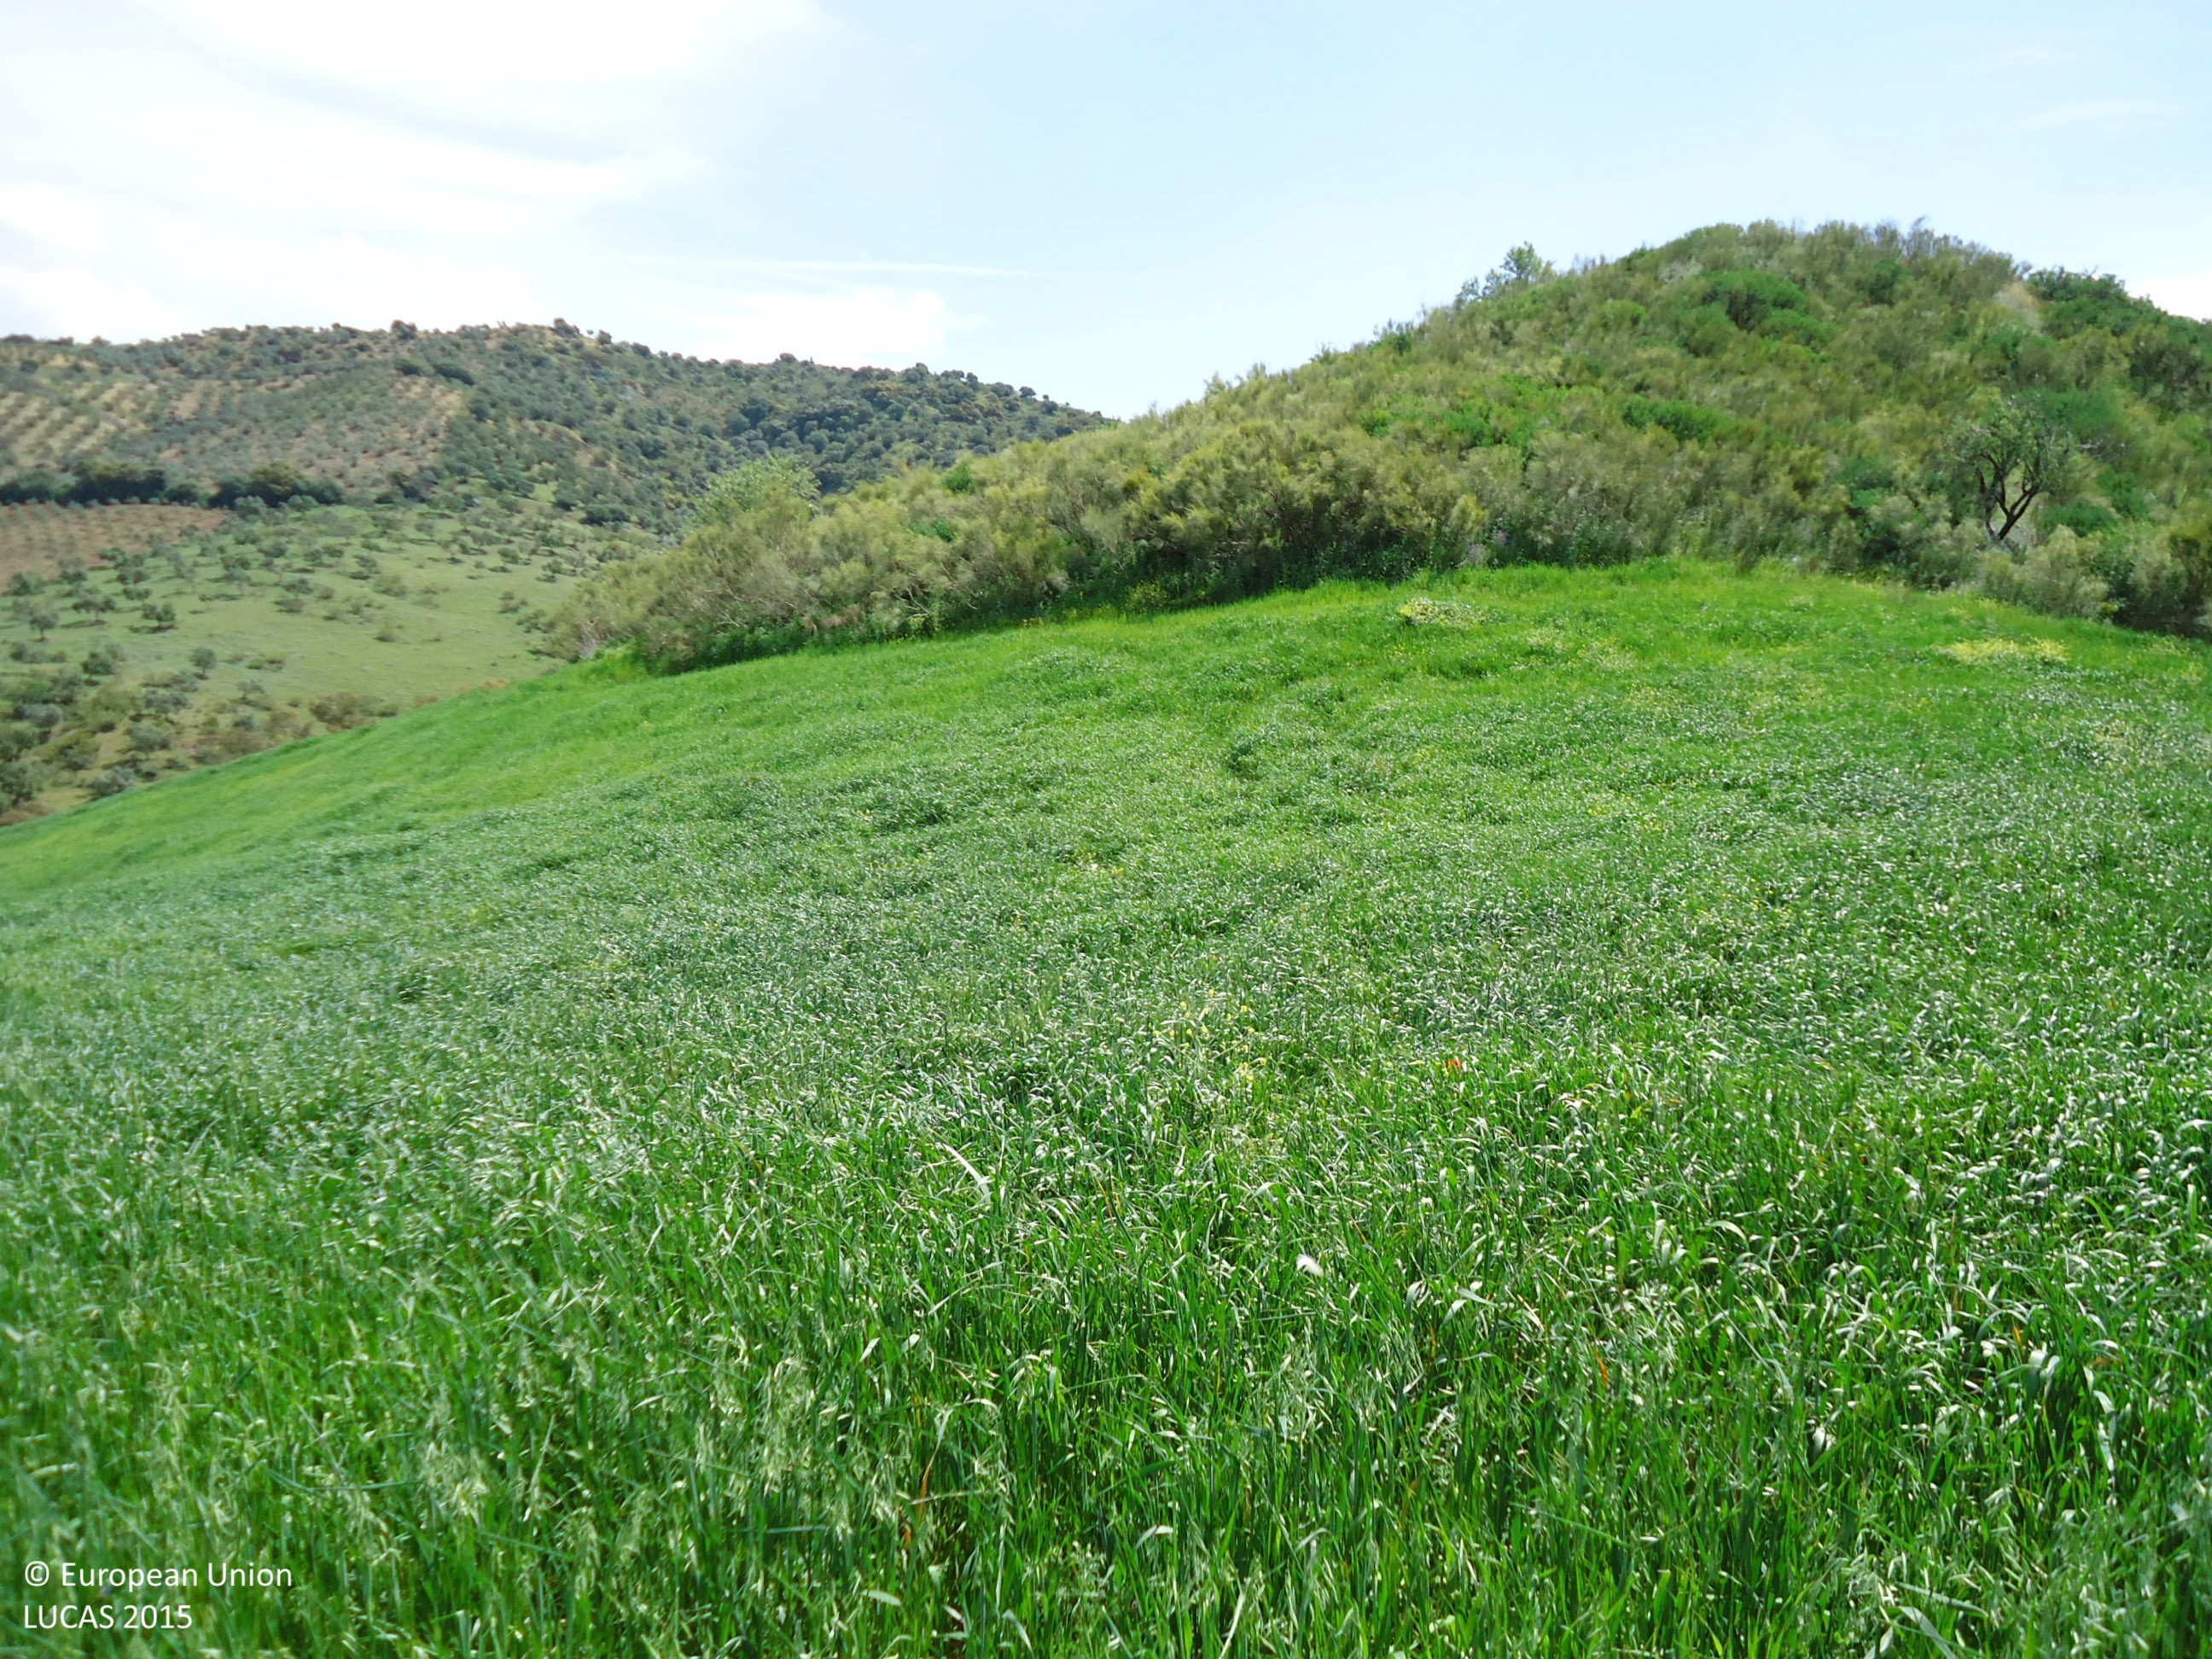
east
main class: Cropland
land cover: Oats
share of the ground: > 75 %
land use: Agriculture (excluding fallow land and kitchen gardens)
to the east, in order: Oats; Shrubland without tree cover; Oats; Grassland with sparse tree/shrub cover; Oats
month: April
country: ES
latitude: 36.8923
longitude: -5.2756
